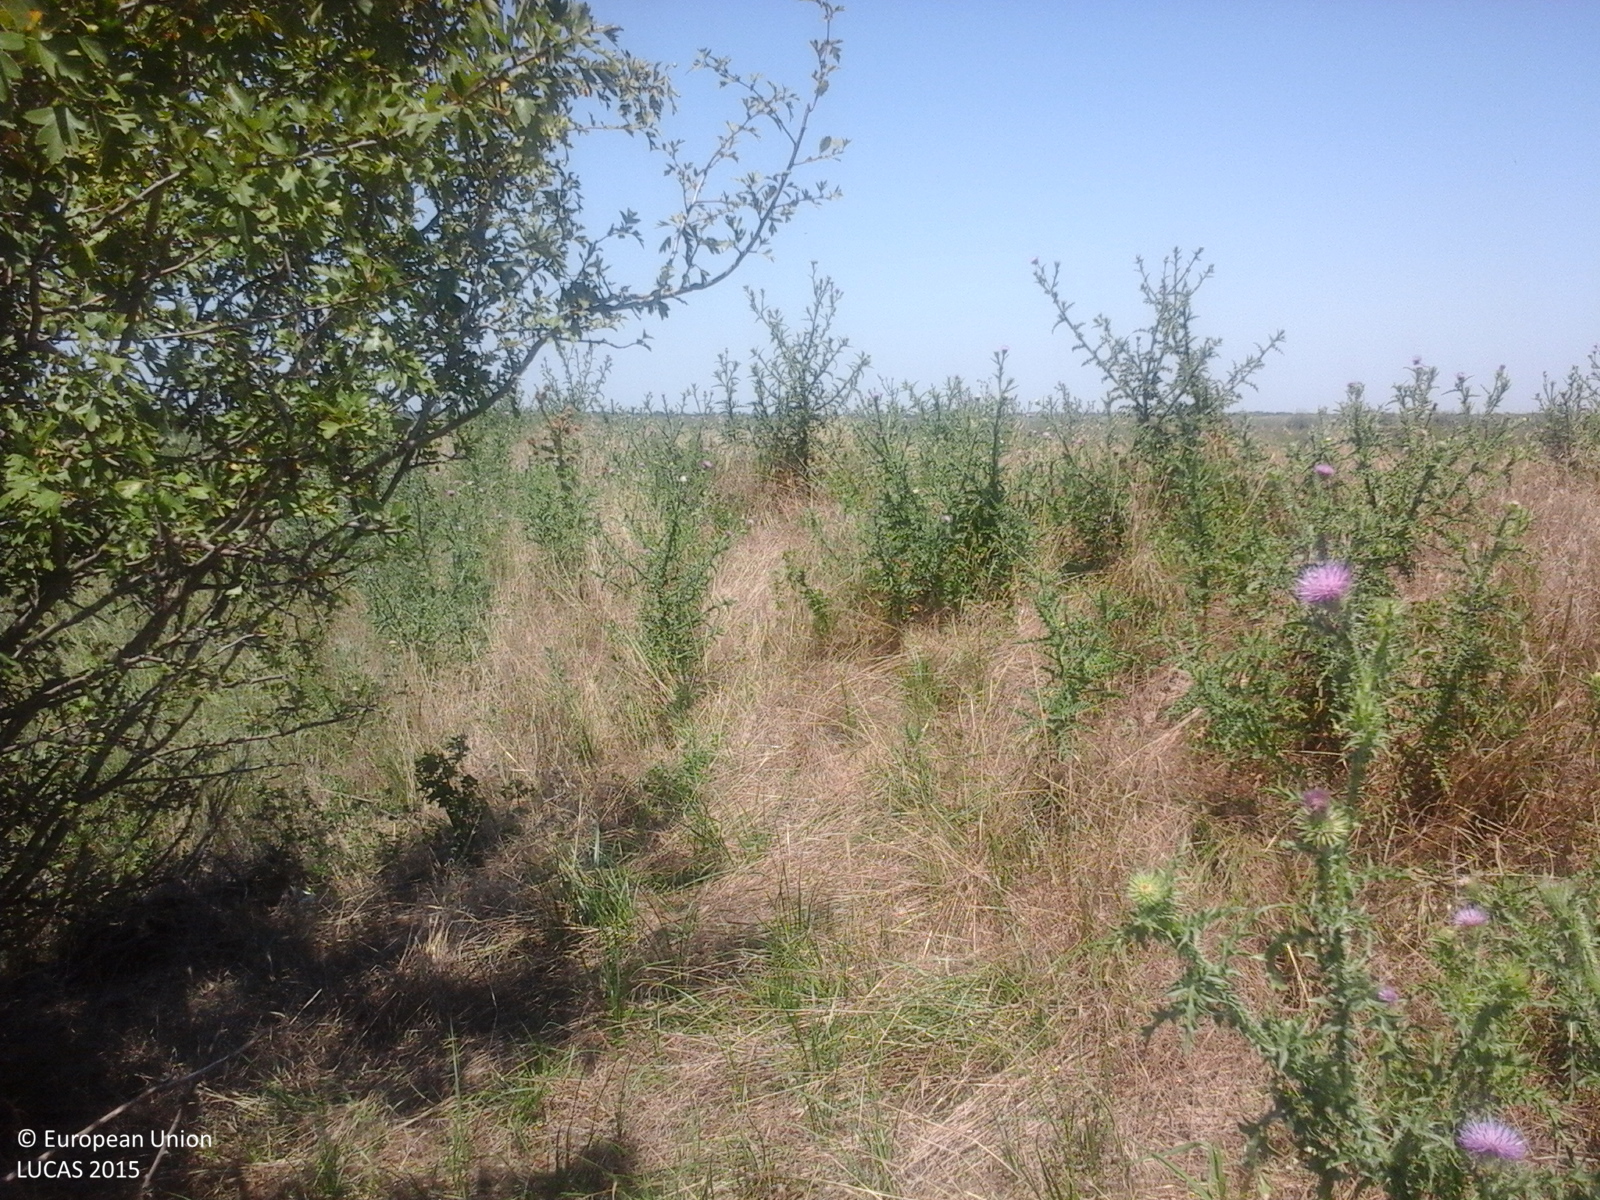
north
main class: Grassland
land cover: Grassland with sparse tree/shrub cover
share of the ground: > 75 %
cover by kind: herbaceous plants 85 %, shrubs 10 %, broadleaved forest trees 5 %
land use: Agriculture (excluding fallow land and kitchen gardens)
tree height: > 5 m
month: July
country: RO
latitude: 44.2608
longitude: 26.4327
